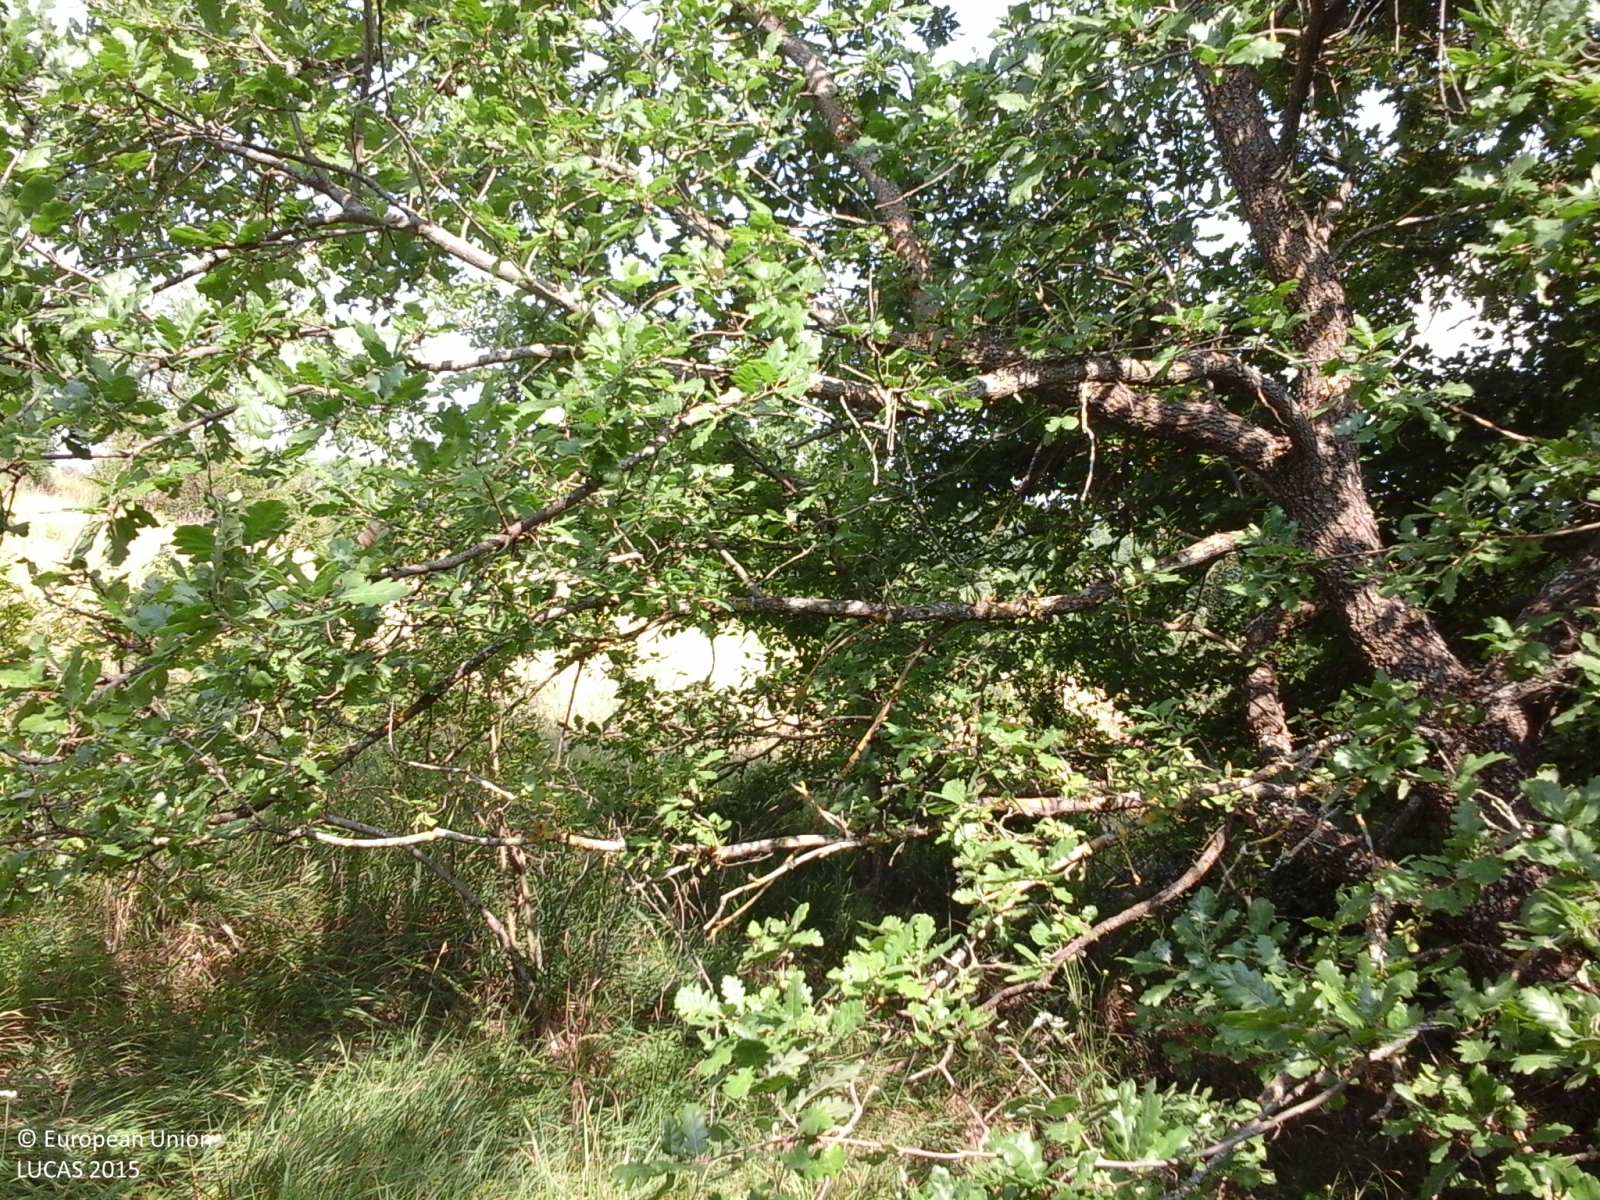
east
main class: Woodland
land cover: Broadleaved woodland
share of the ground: > 75 %
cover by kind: herbaceous plants 65 %, broadleaved forest trees 25 %, shrubs 10 %
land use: Semi-natural and natural areas not in use
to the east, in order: Broadleaved woodland; Grassland with sparse tree/shrub cover; Oats; Grassland without tree/shrub cover; Broadleaved woodland
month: August
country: IT
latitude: 41.5778
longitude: 14.4819
